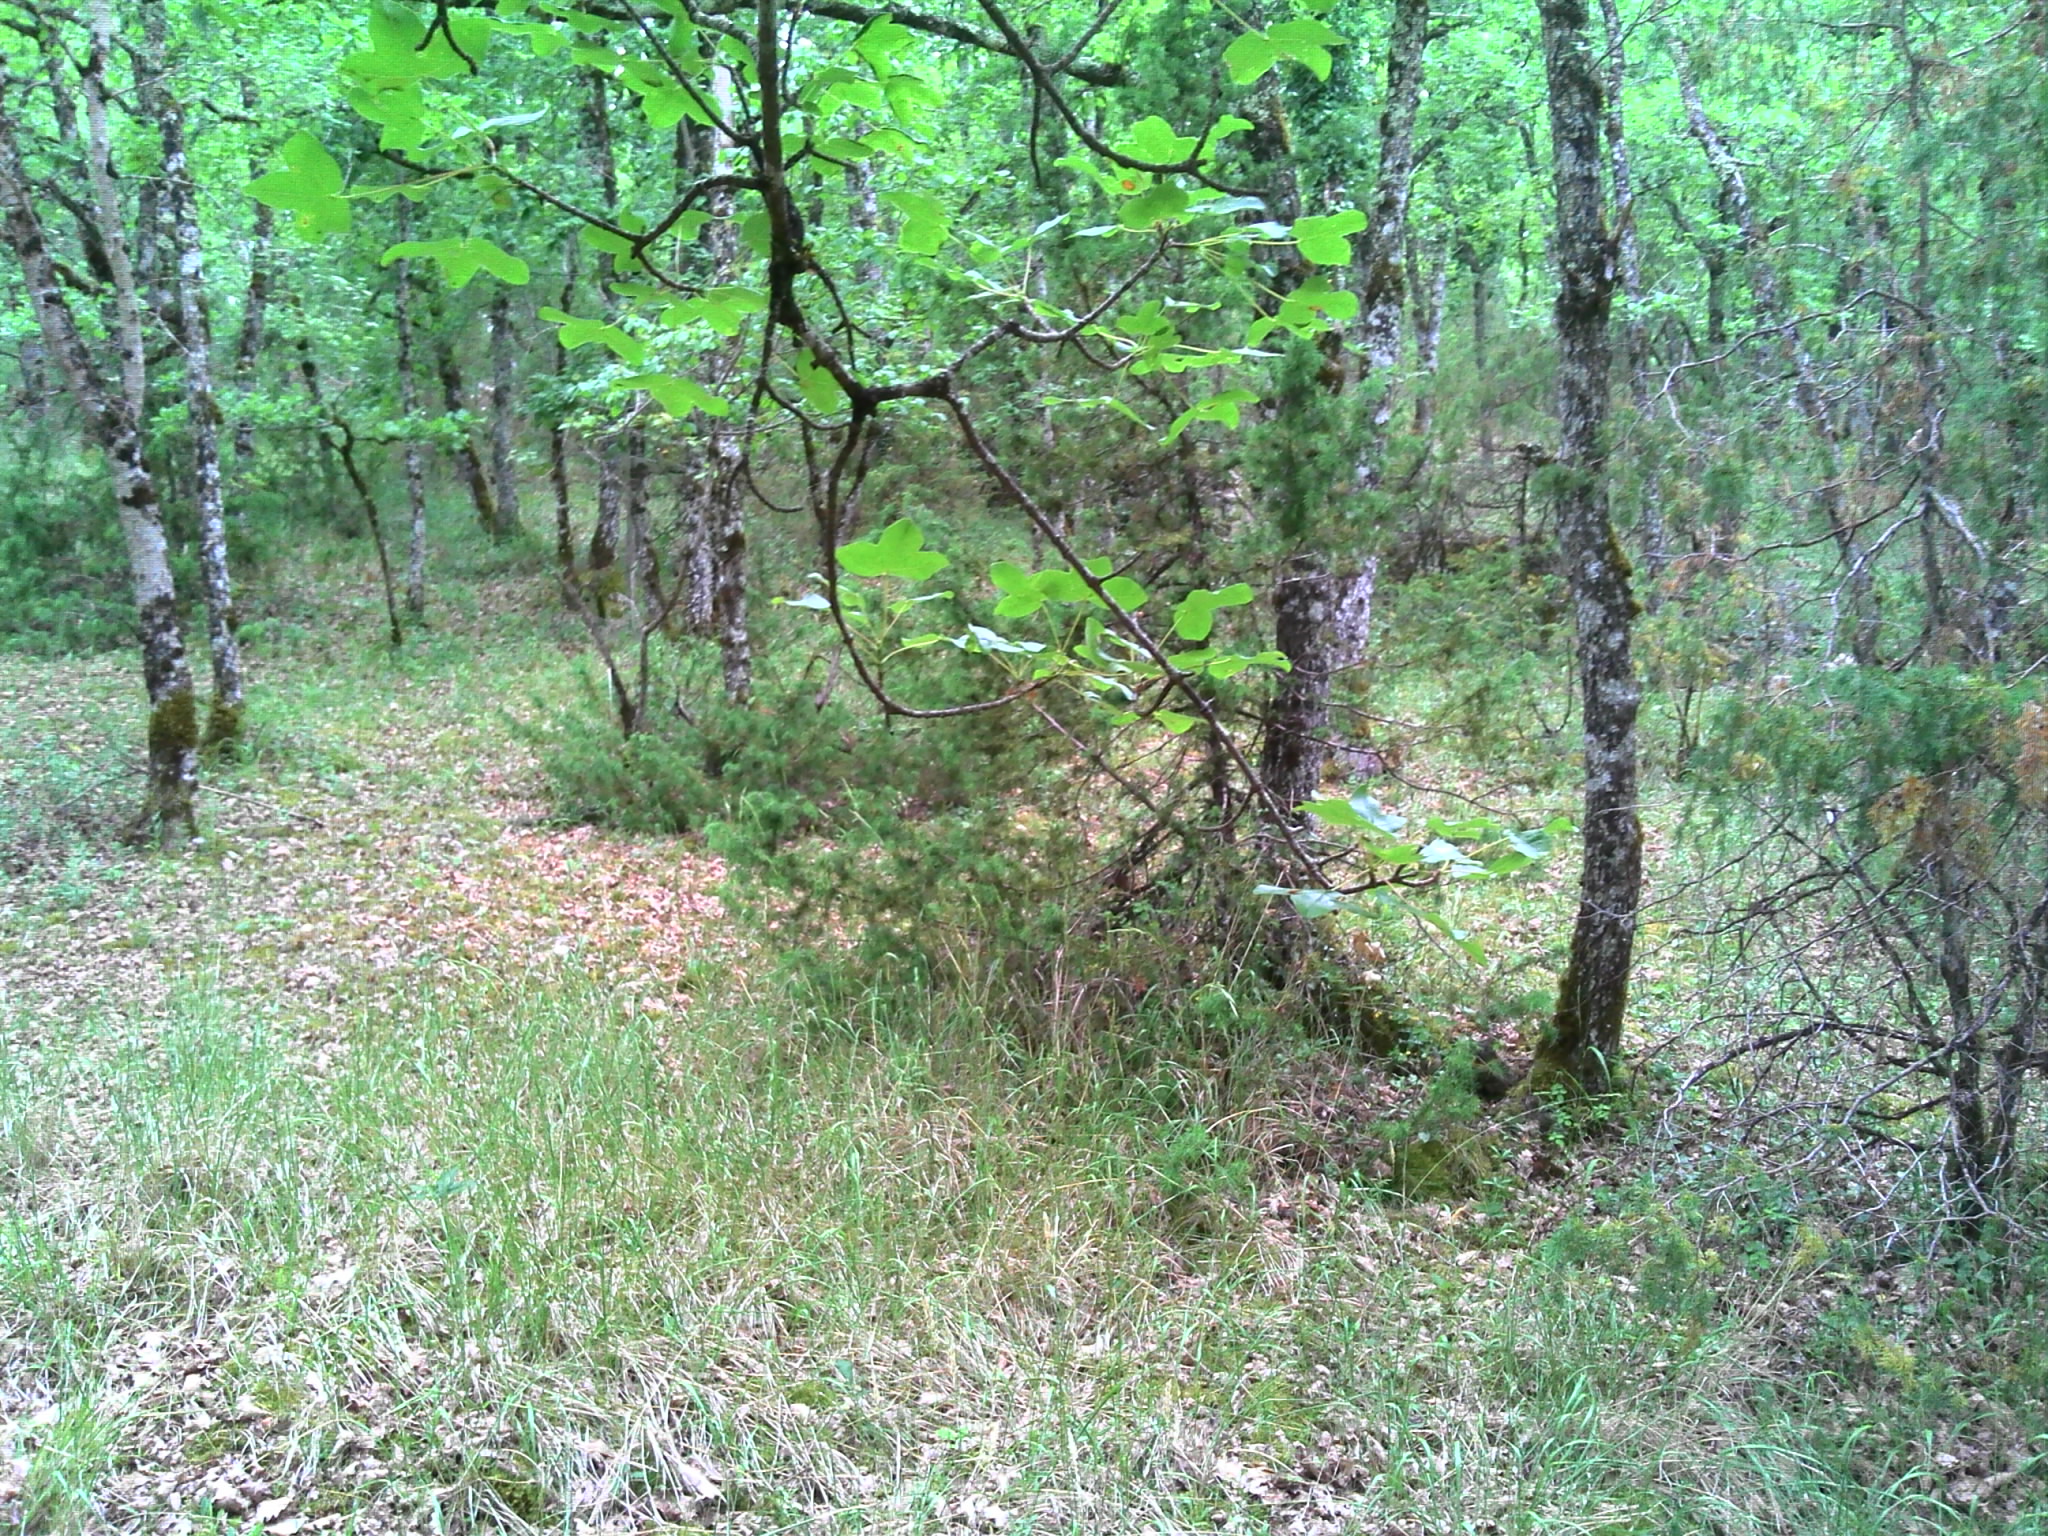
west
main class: Woodland
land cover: Broadleaved woodland
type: thermophilous deciduous forest
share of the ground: > 75 %
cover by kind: broadleaved forest trees 85 %, lichens and mosses 10 %, herbaceous plants 5 %
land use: Forestry
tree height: > 5 m
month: June
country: FR
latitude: 44.5753
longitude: 1.6493
